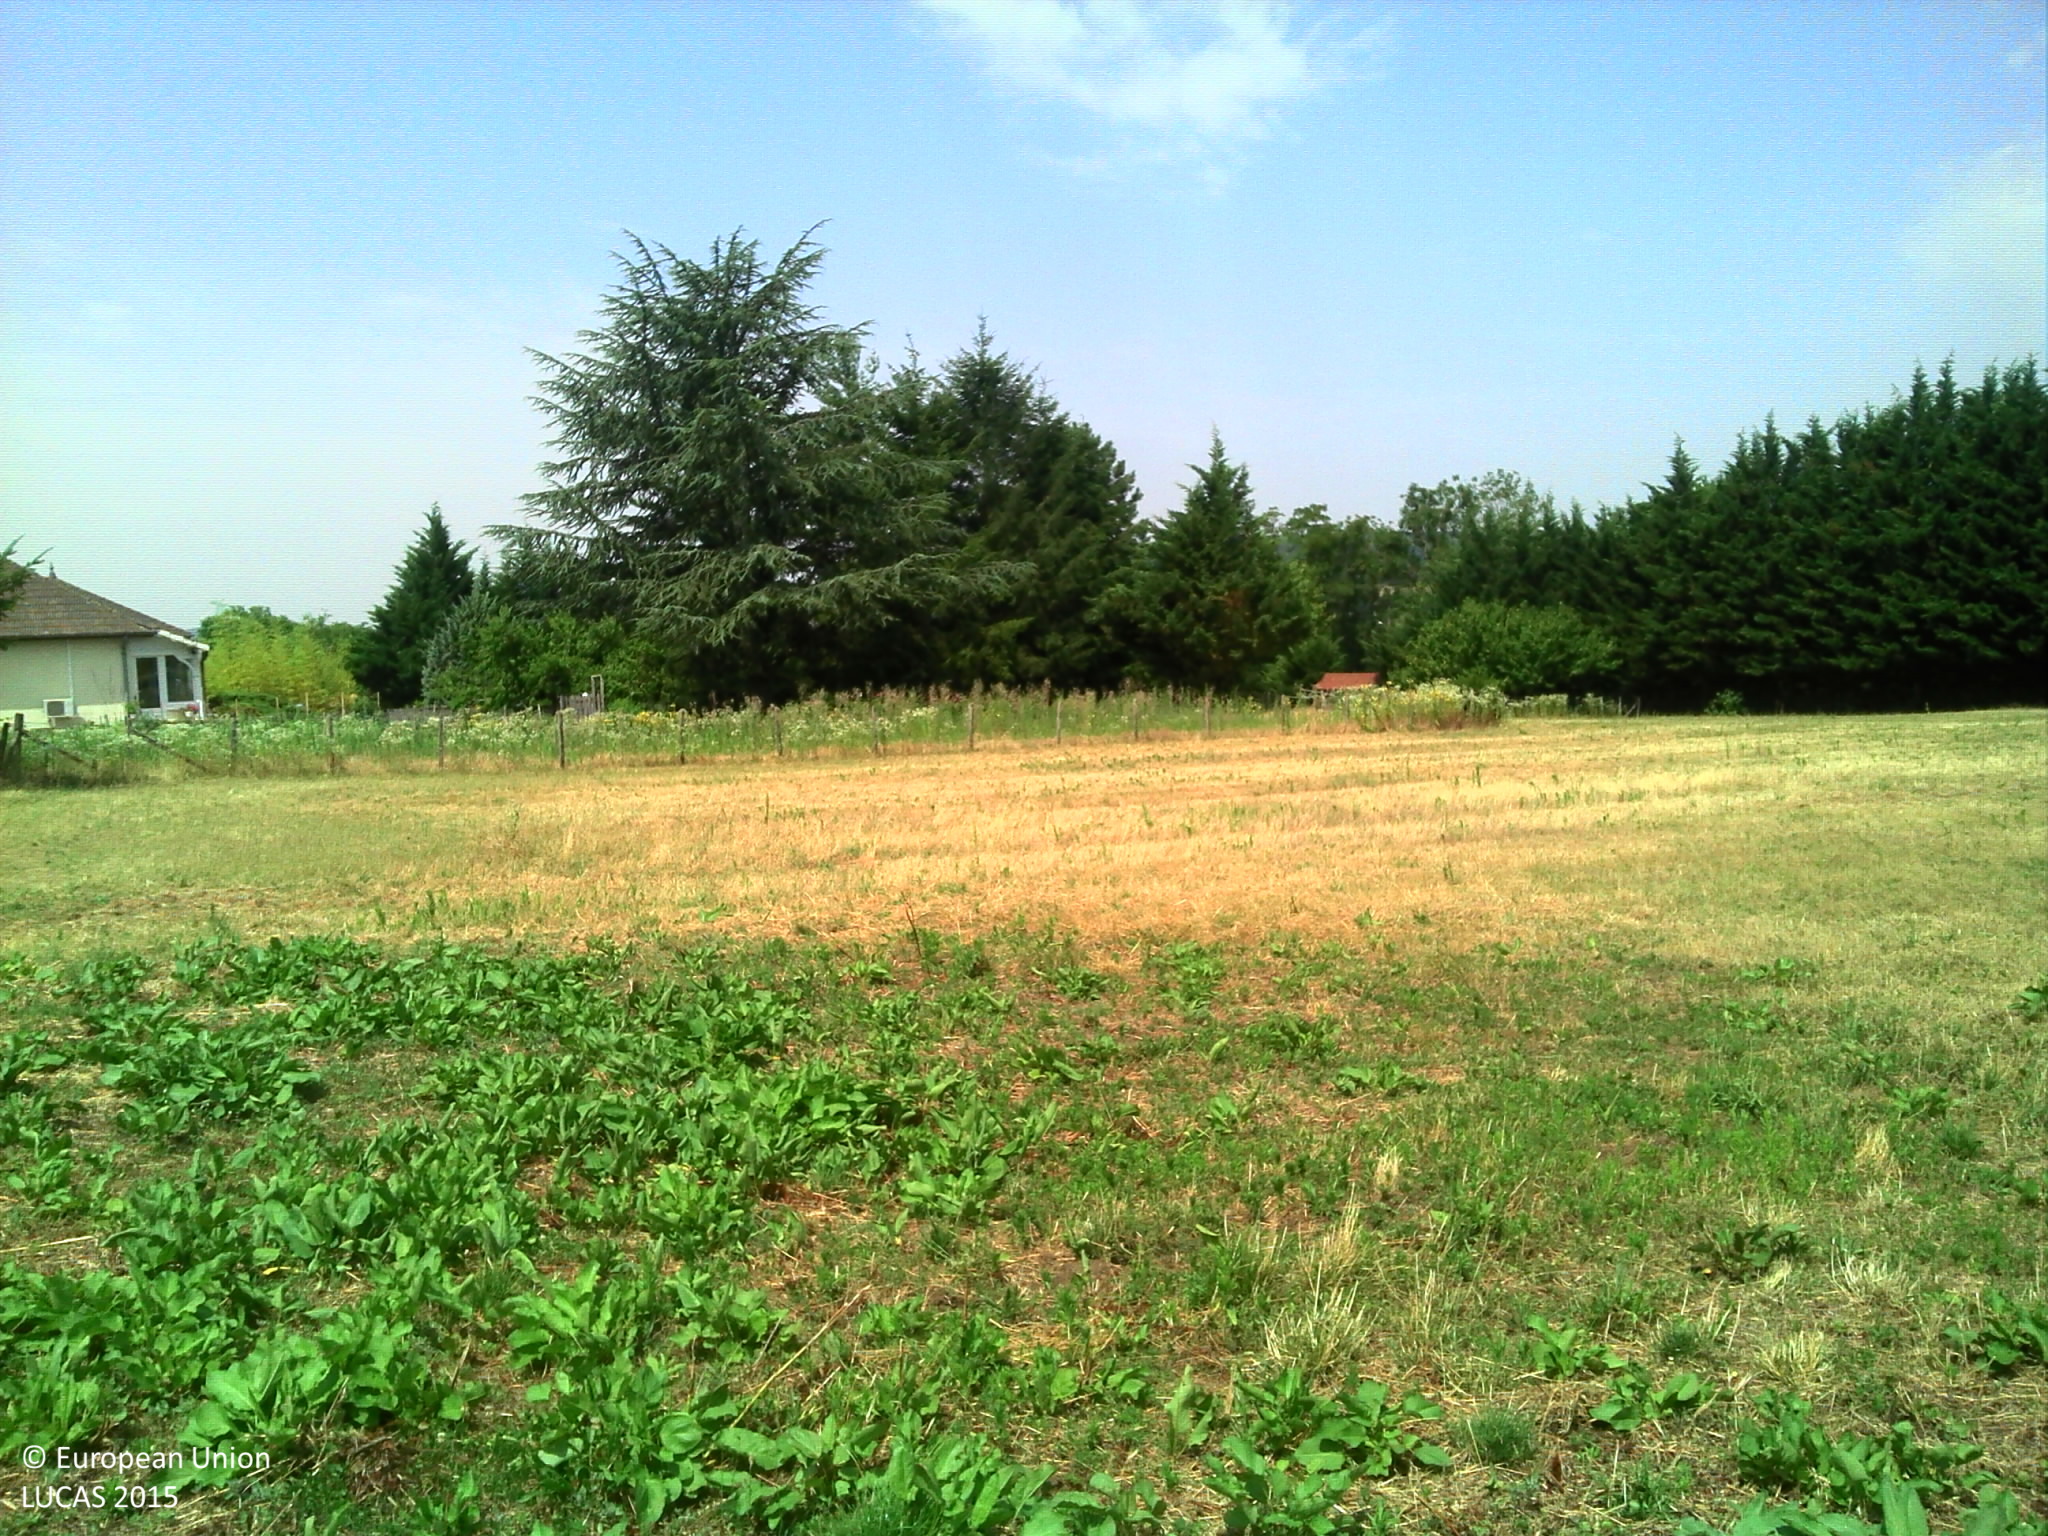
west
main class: Grassland
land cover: Grassland without tree/shrub cover
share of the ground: > 75 %
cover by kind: herbaceous plants 100 %
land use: Agriculture (excluding fallow land and kitchen gardens)
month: July
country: FR
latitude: 45.6927
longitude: 5.3941
